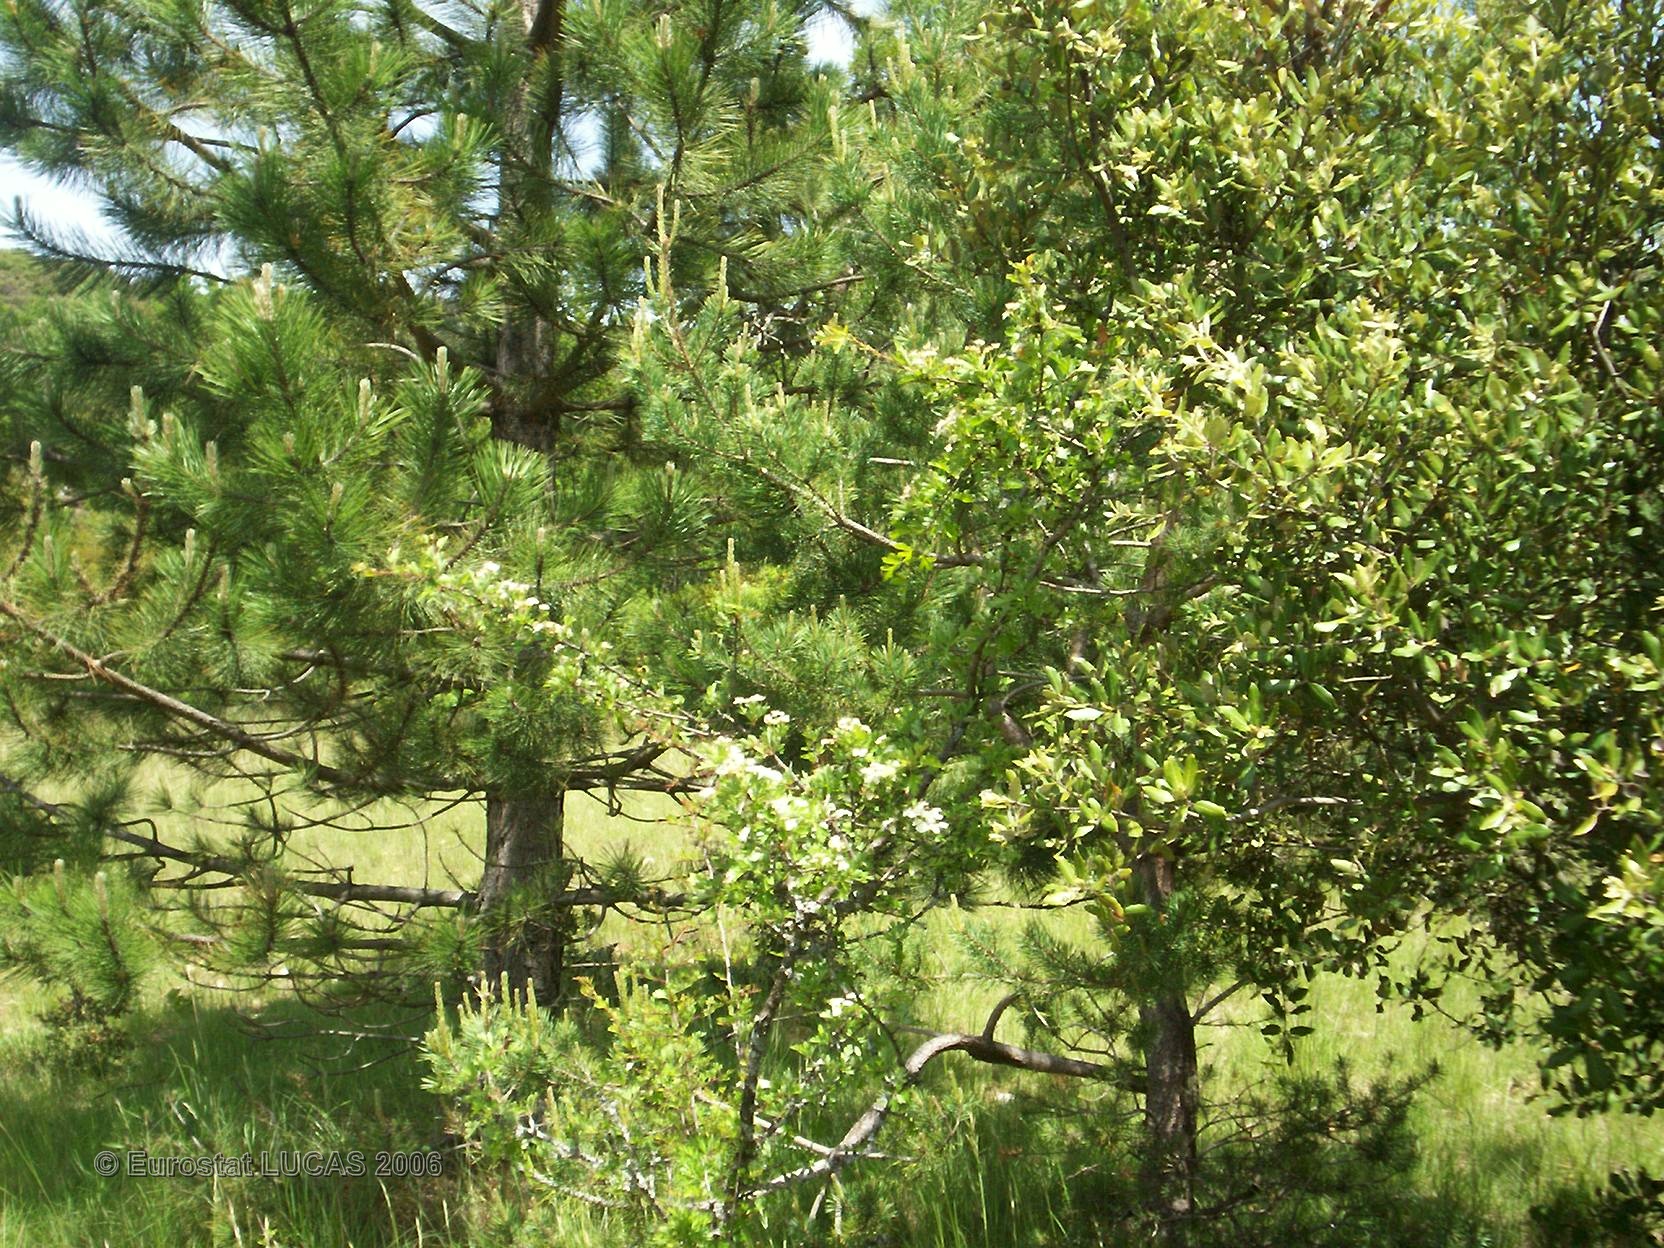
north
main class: Grassland
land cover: Grassland with sparse tree/shrub cover
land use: Agriculture (excluding fallow land and kitchen gardens)
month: May
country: FR
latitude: 44.0095
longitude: 5.3061
